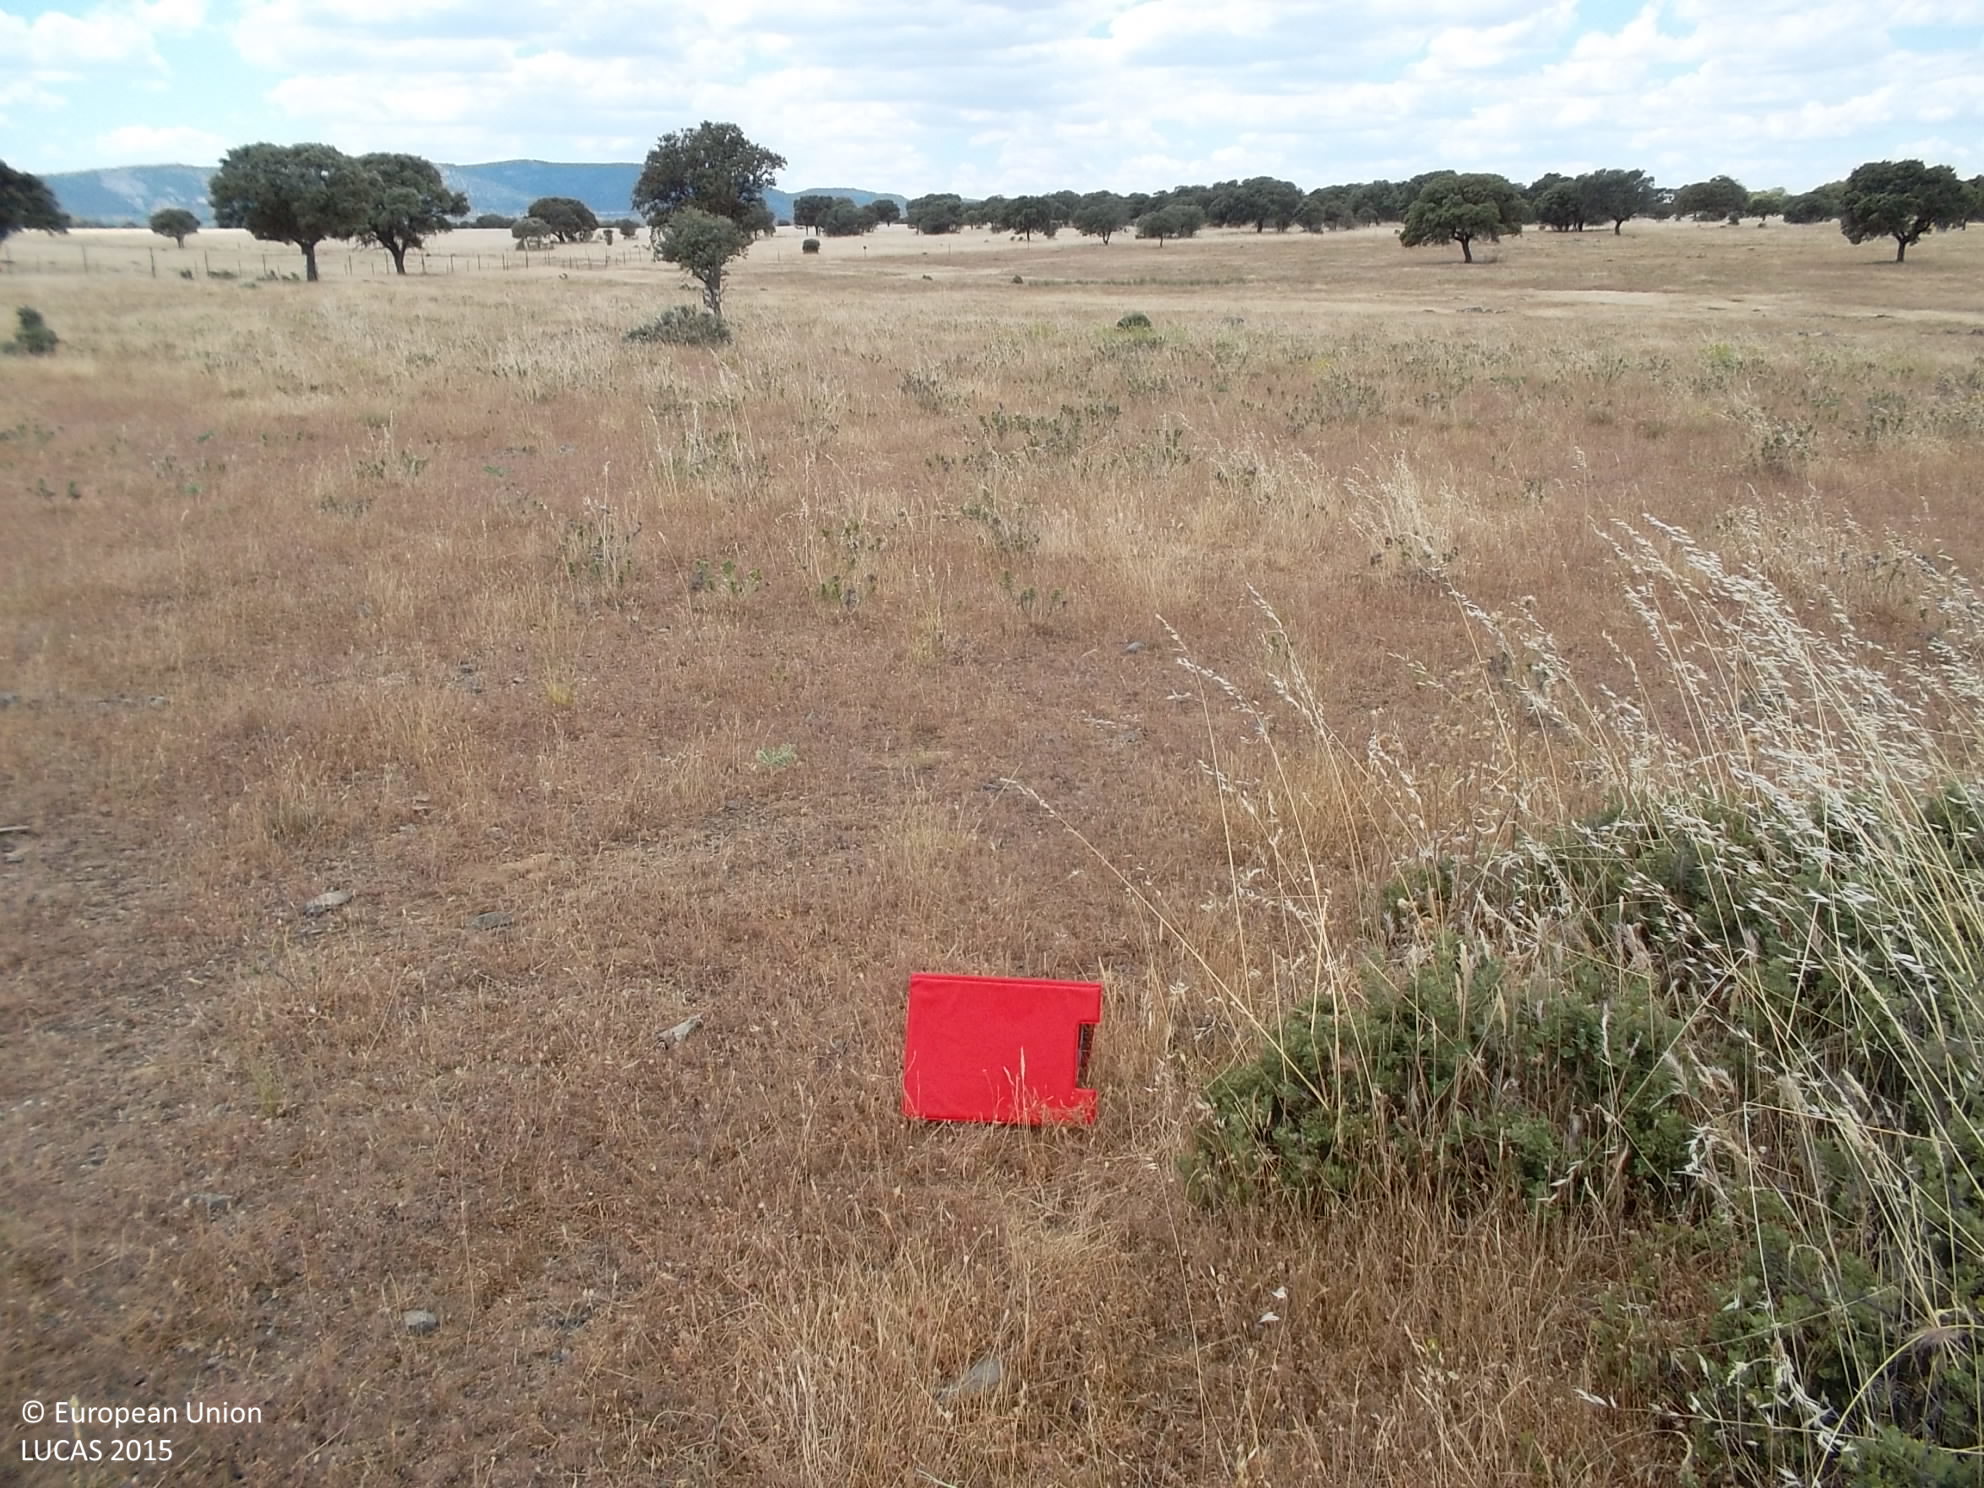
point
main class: Grassland
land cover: Grassland without tree/shrub cover
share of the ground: > 75 %
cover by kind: herbaceous plants 100 %
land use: Agriculture (excluding fallow land and kitchen gardens)
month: May
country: ES
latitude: 38.5778
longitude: -4.3801
